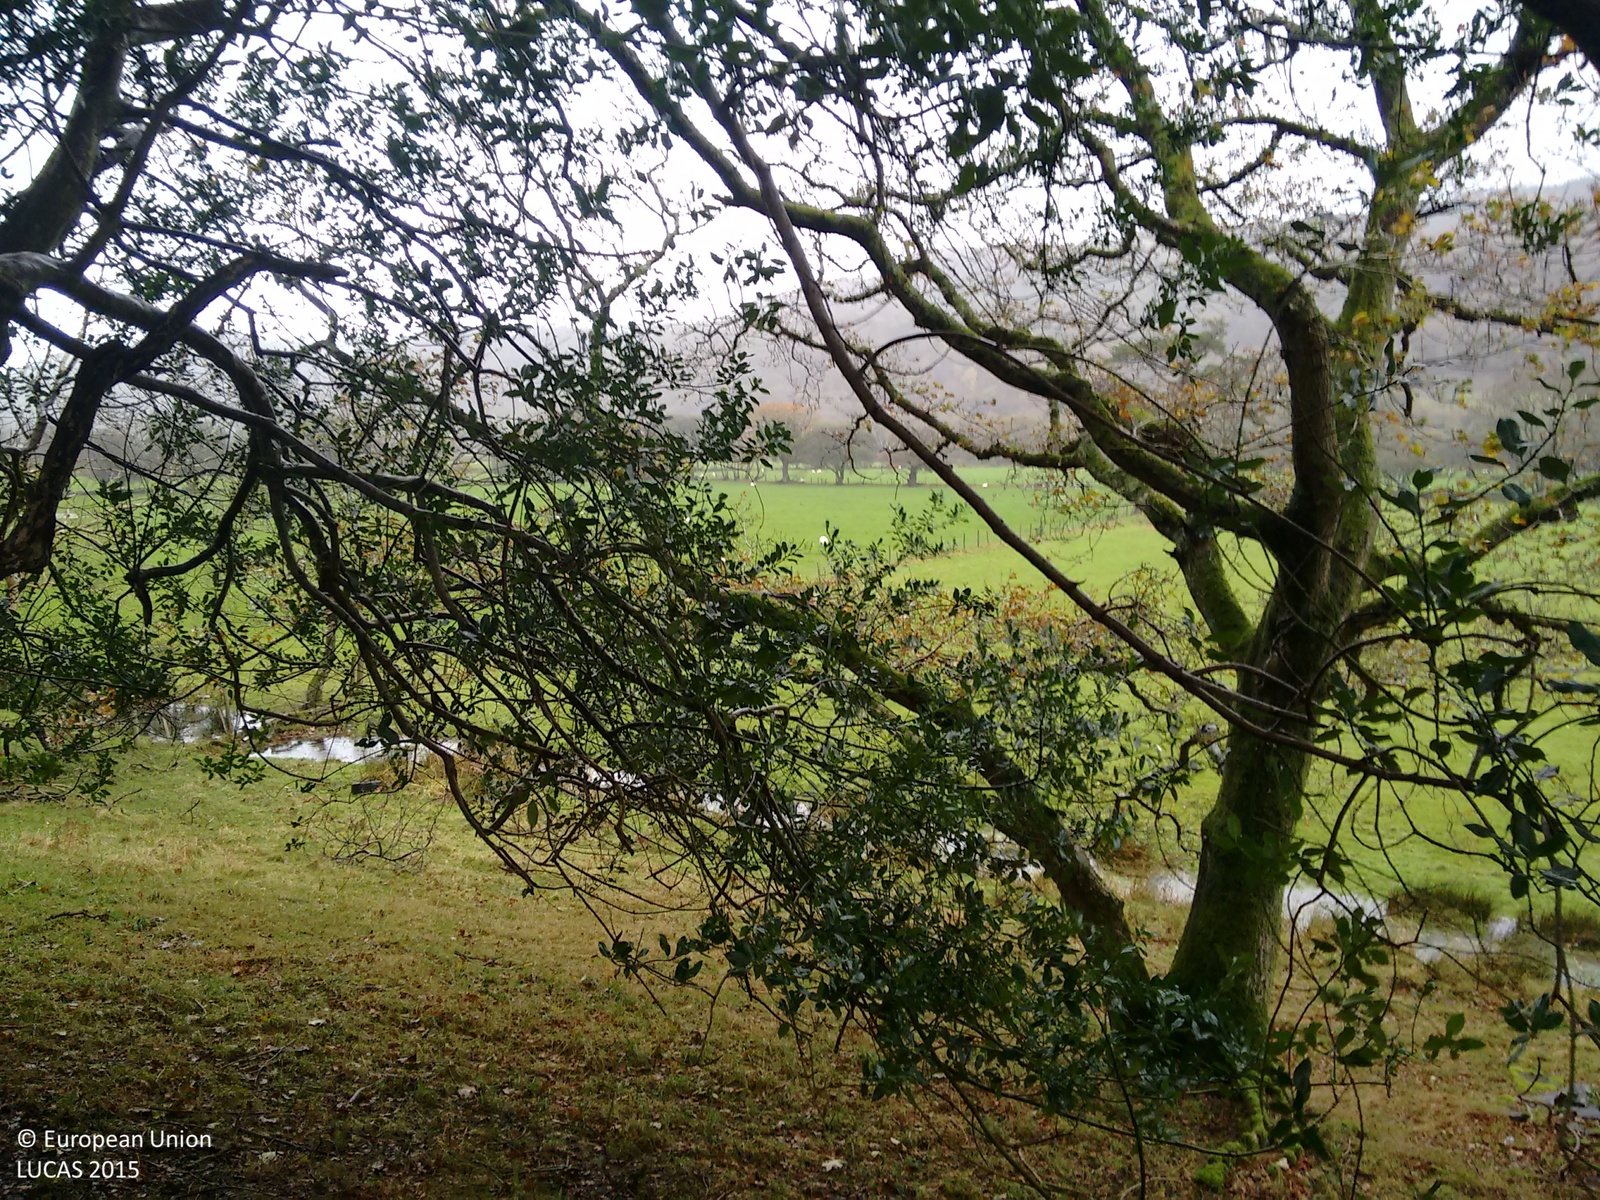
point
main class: Grassland
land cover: Grassland without tree/shrub cover
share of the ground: > 75 %
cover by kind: herbaceous plants 100 %
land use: Agriculture (excluding fallow land and kitchen gardens)
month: November
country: GB
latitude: 52.9507
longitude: -3.9803
